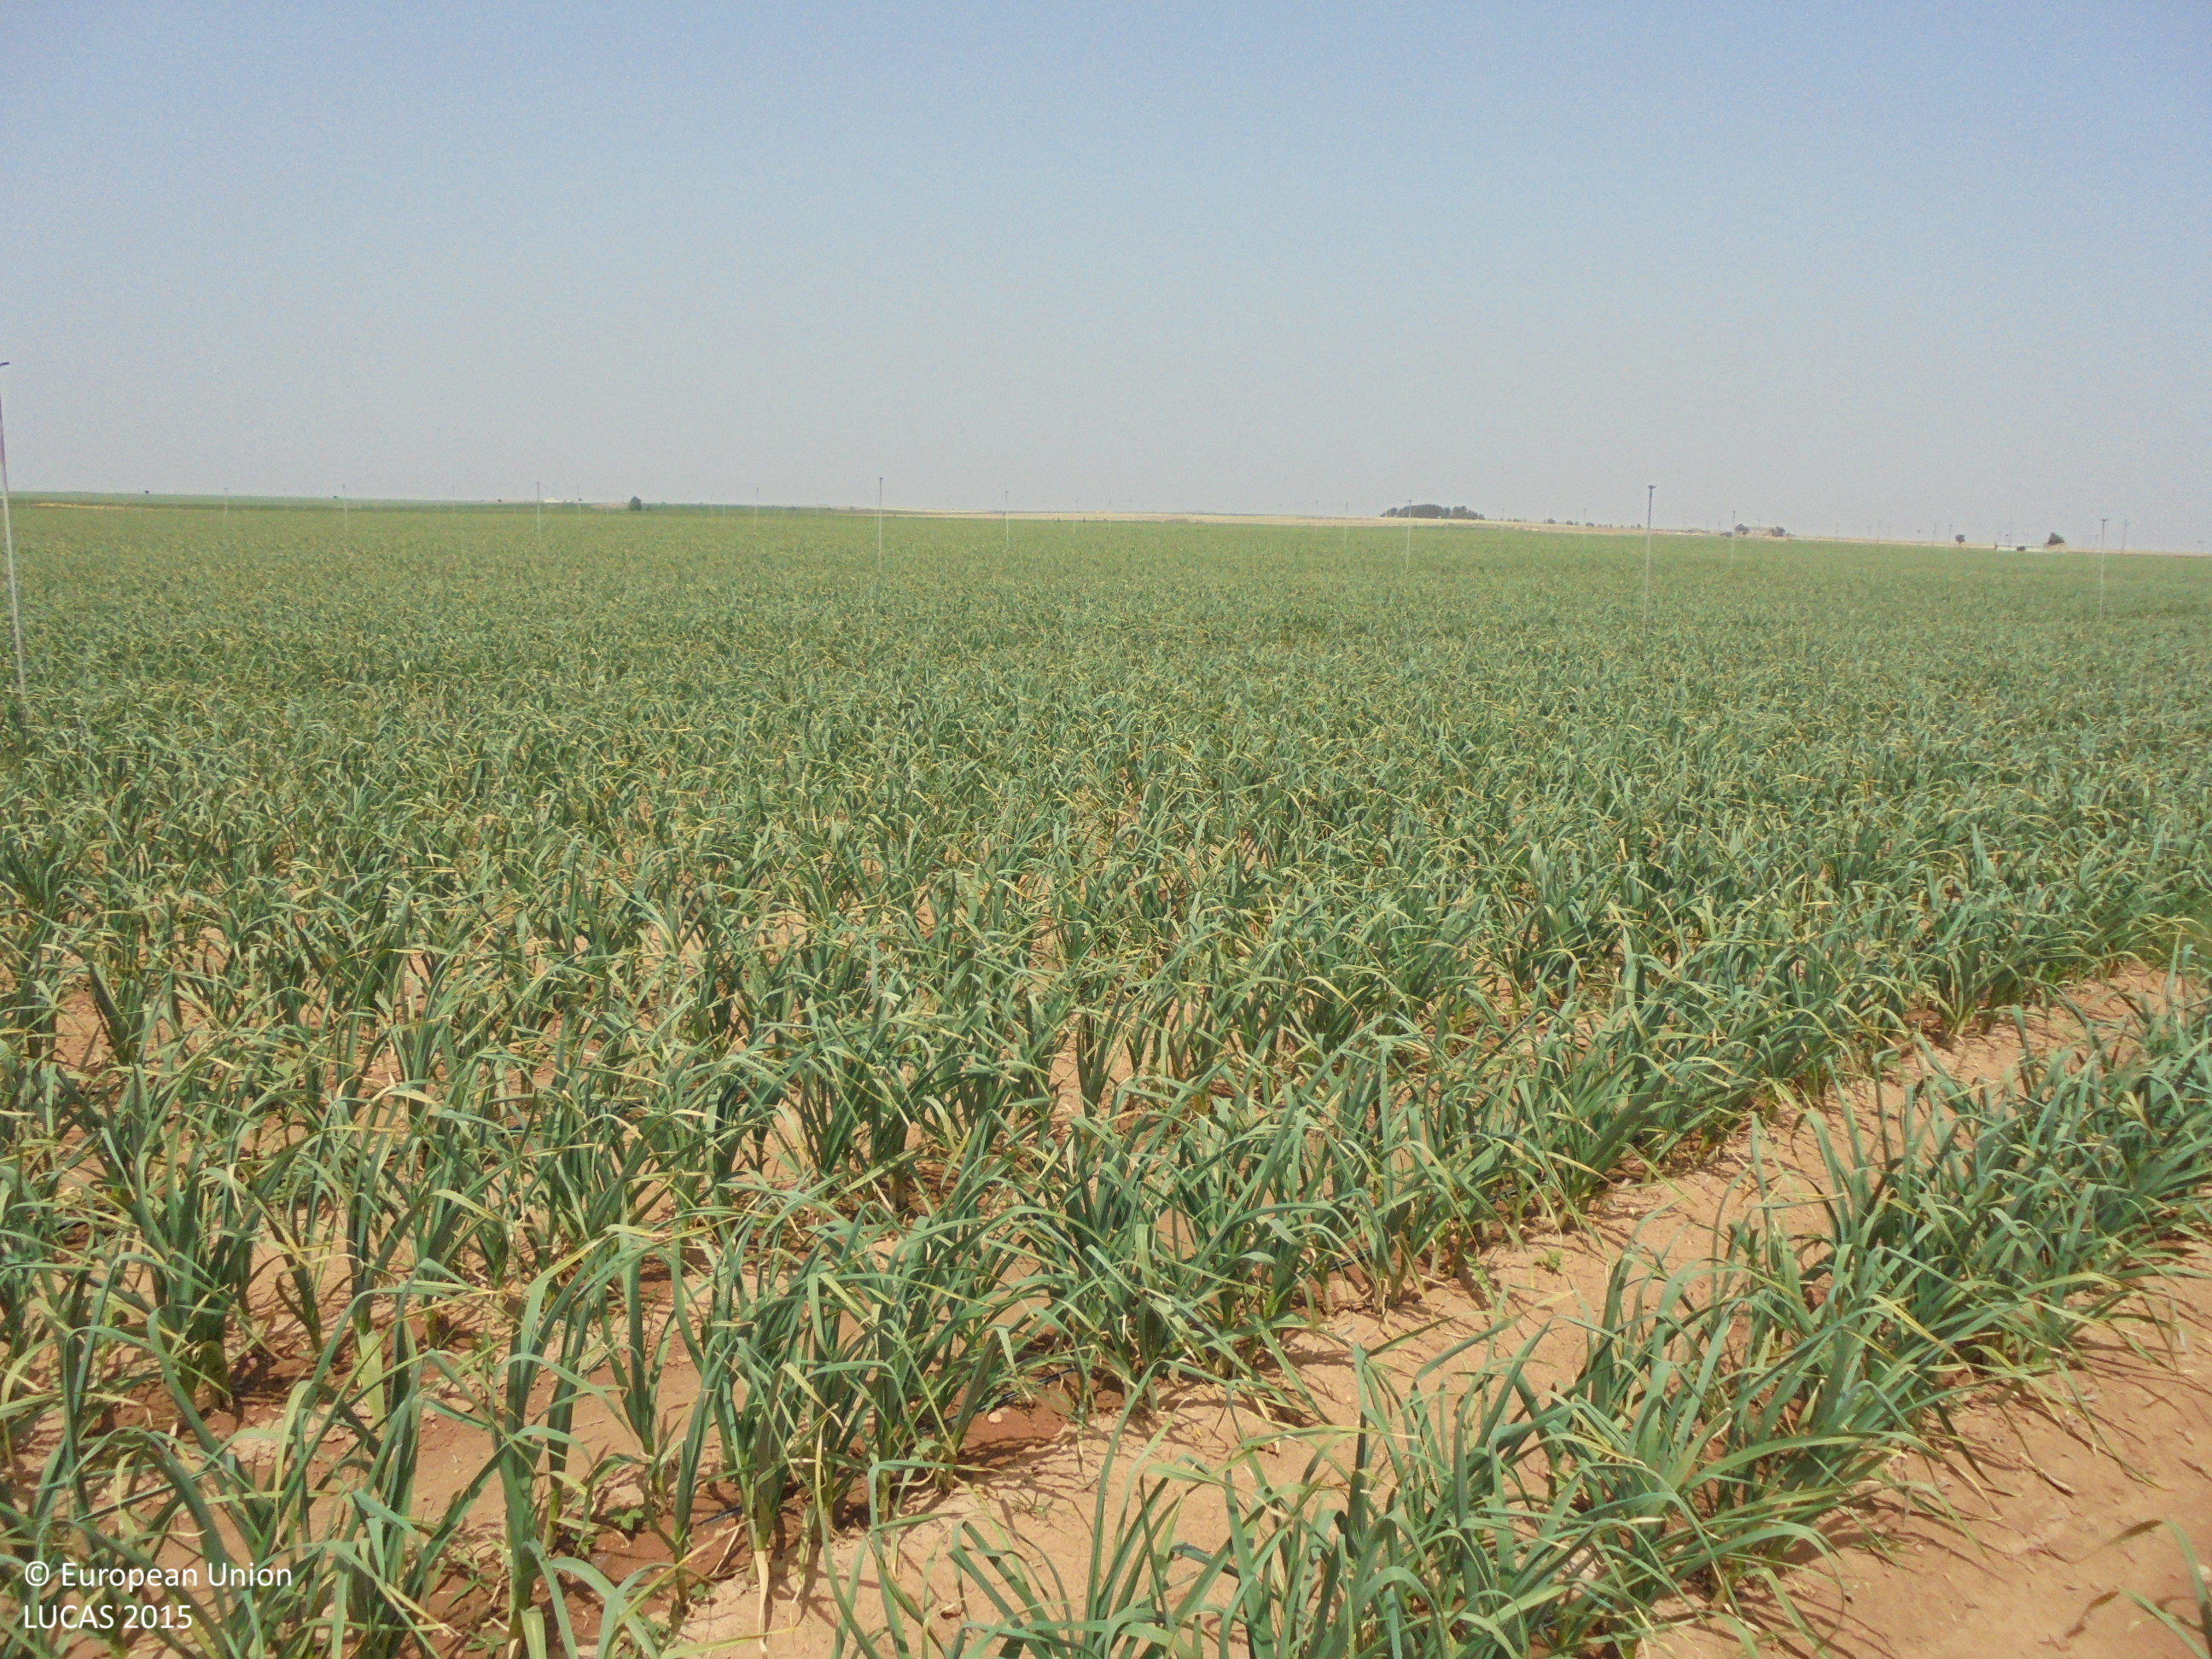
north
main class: Cropland
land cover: Other root crops
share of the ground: 25 - 50 %
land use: Agriculture (excluding fallow land and kitchen gardens)
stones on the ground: < 10 %
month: May
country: ES
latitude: 39.0855
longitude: -1.7347
